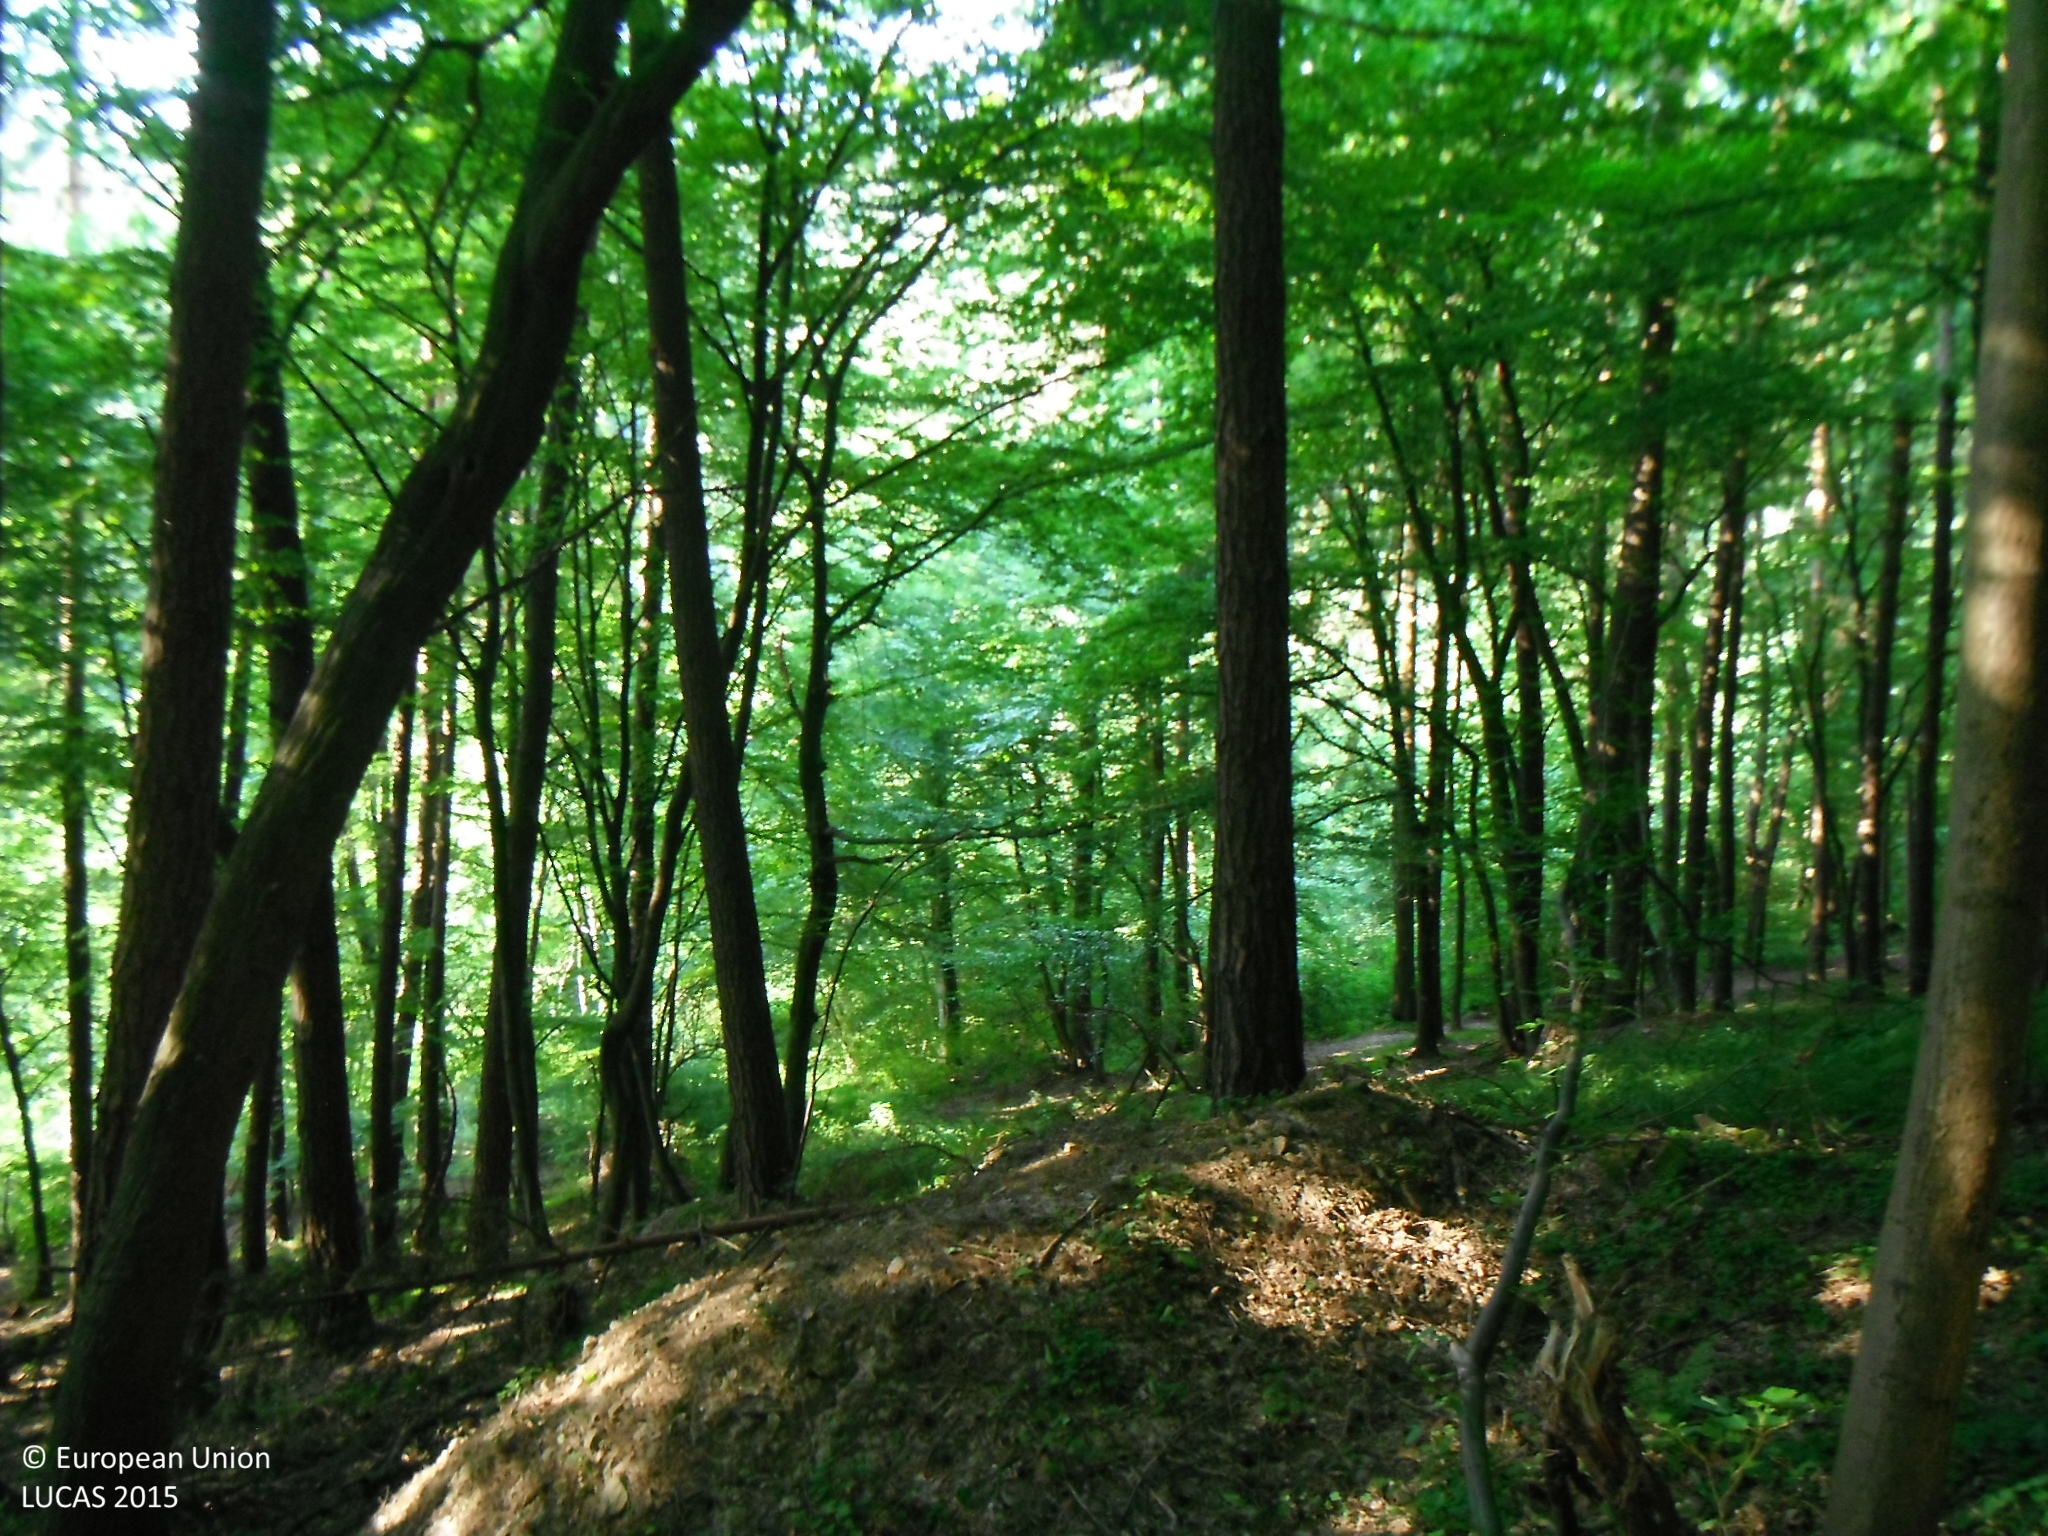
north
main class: Woodland
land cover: Pine dominated mixed woodland
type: hemiboreal forest and nemoral coniferous forest and mixed broadleaved-coniferous forest
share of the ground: > 75 %
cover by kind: coniferous forest trees 50 %, broadleaved forest trees 50 %
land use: Forestry
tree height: > 5 m
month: July
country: SK
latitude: 49.1091
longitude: 18.4699
